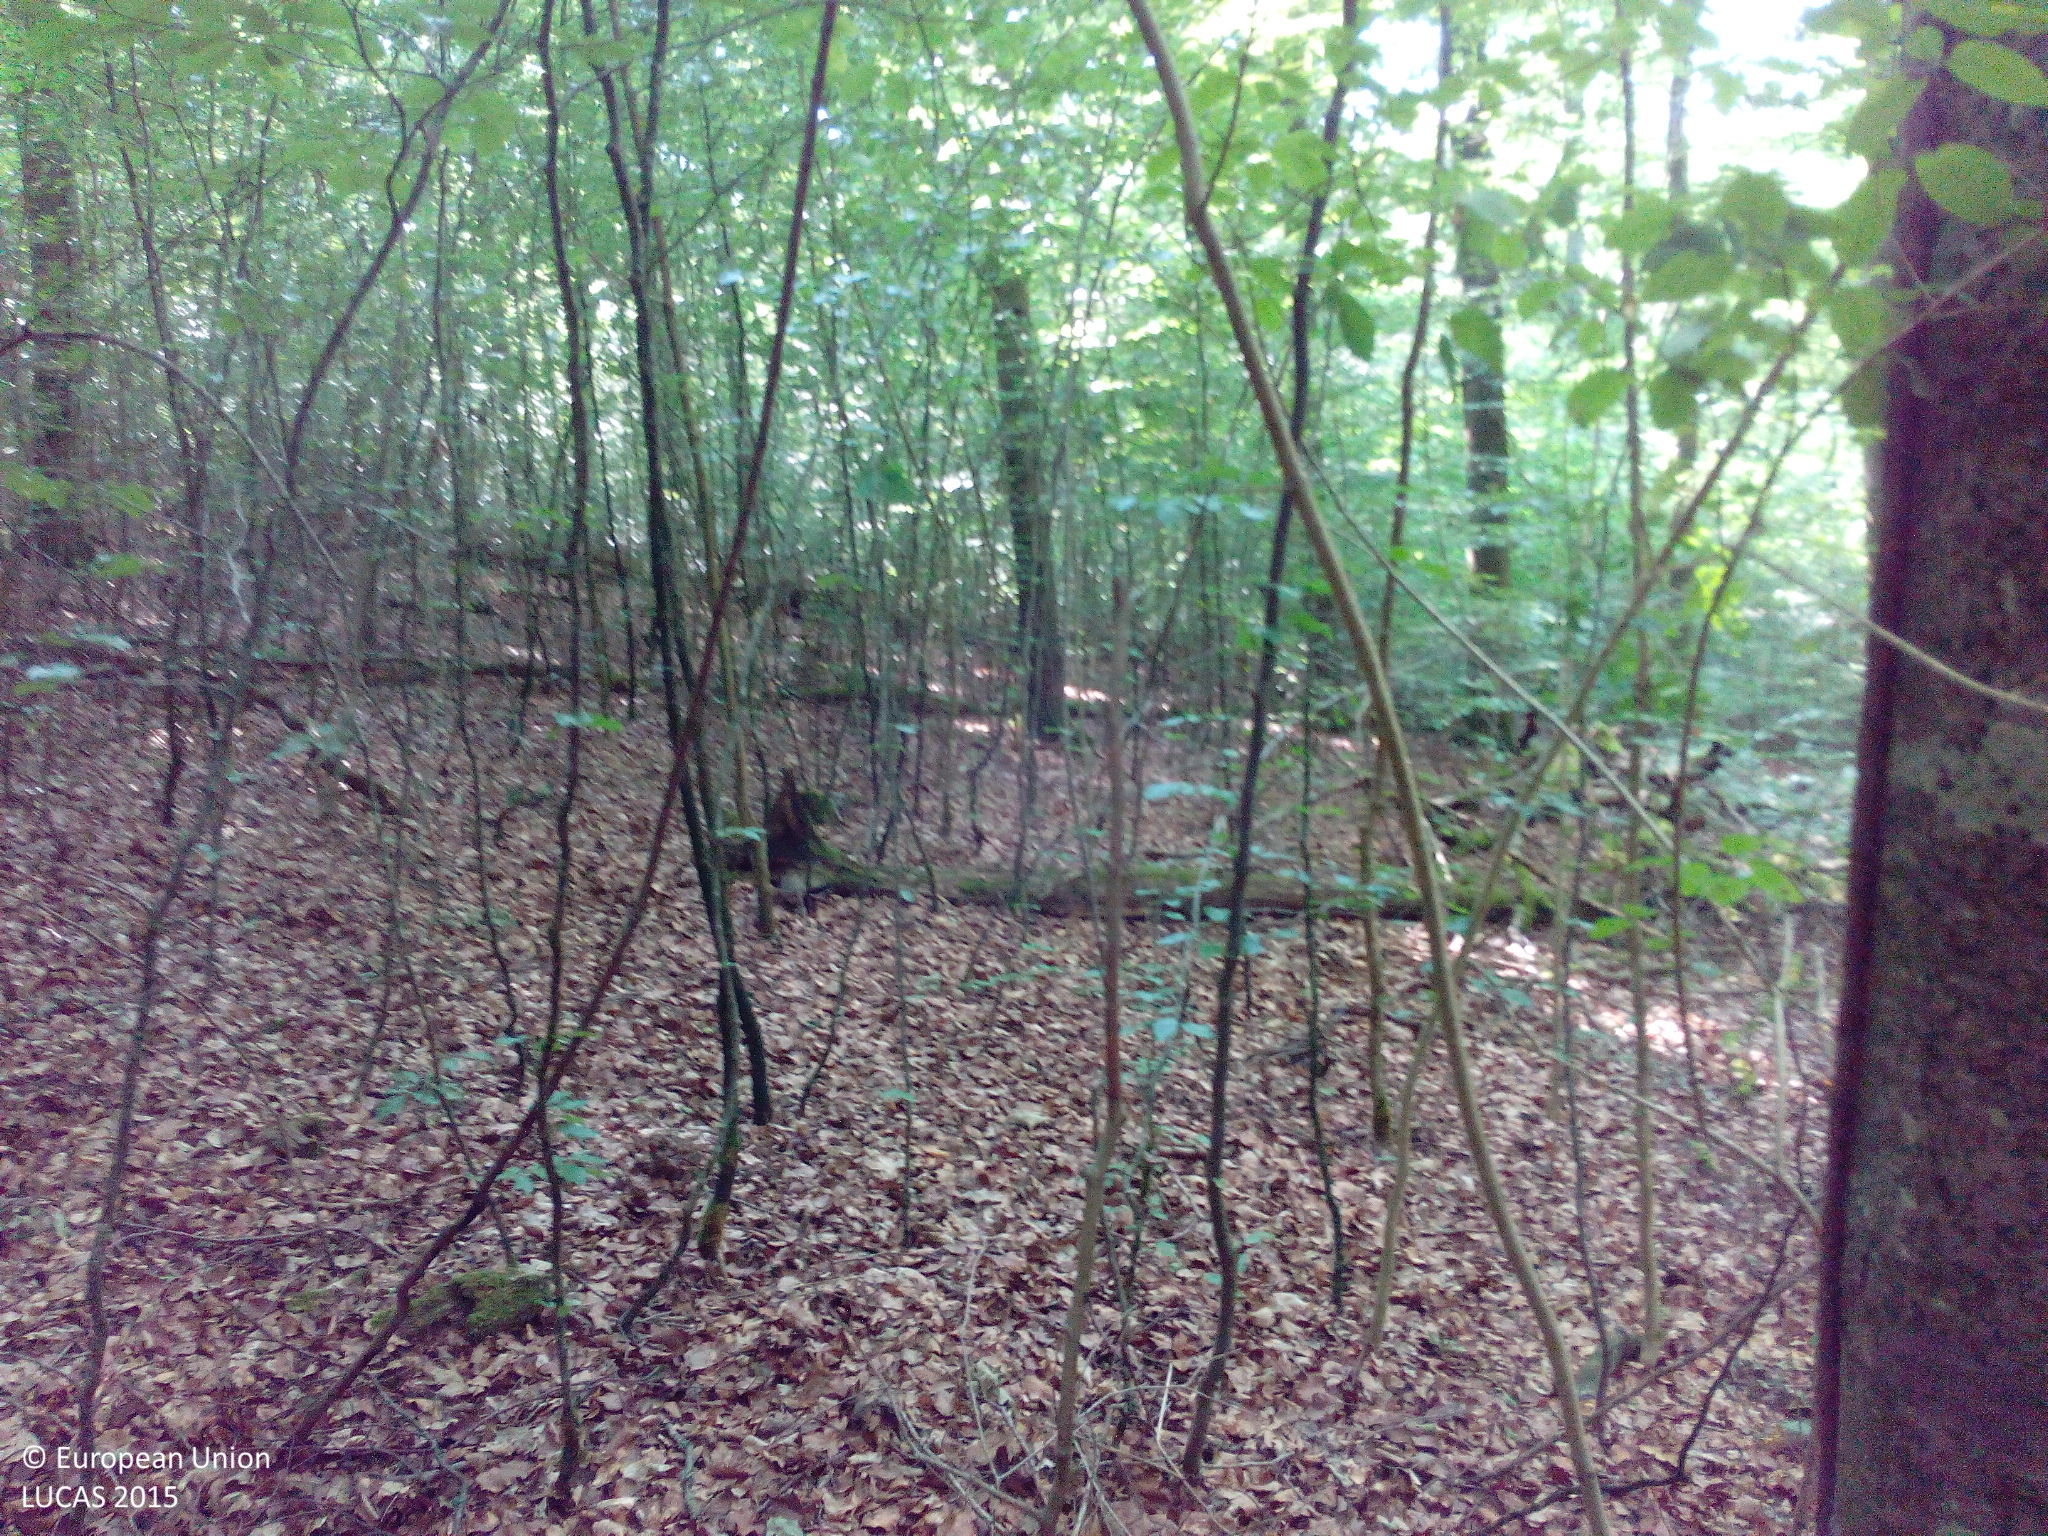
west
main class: Woodland
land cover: Broadleaved woodland
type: mesophytic deciduous forest
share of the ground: > 75 %
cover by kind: broadleaved forest trees 100 %
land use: Forestry
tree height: > 5 m
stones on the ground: < 10 %
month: July
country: DE
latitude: 49.7706
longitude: 9.9028
